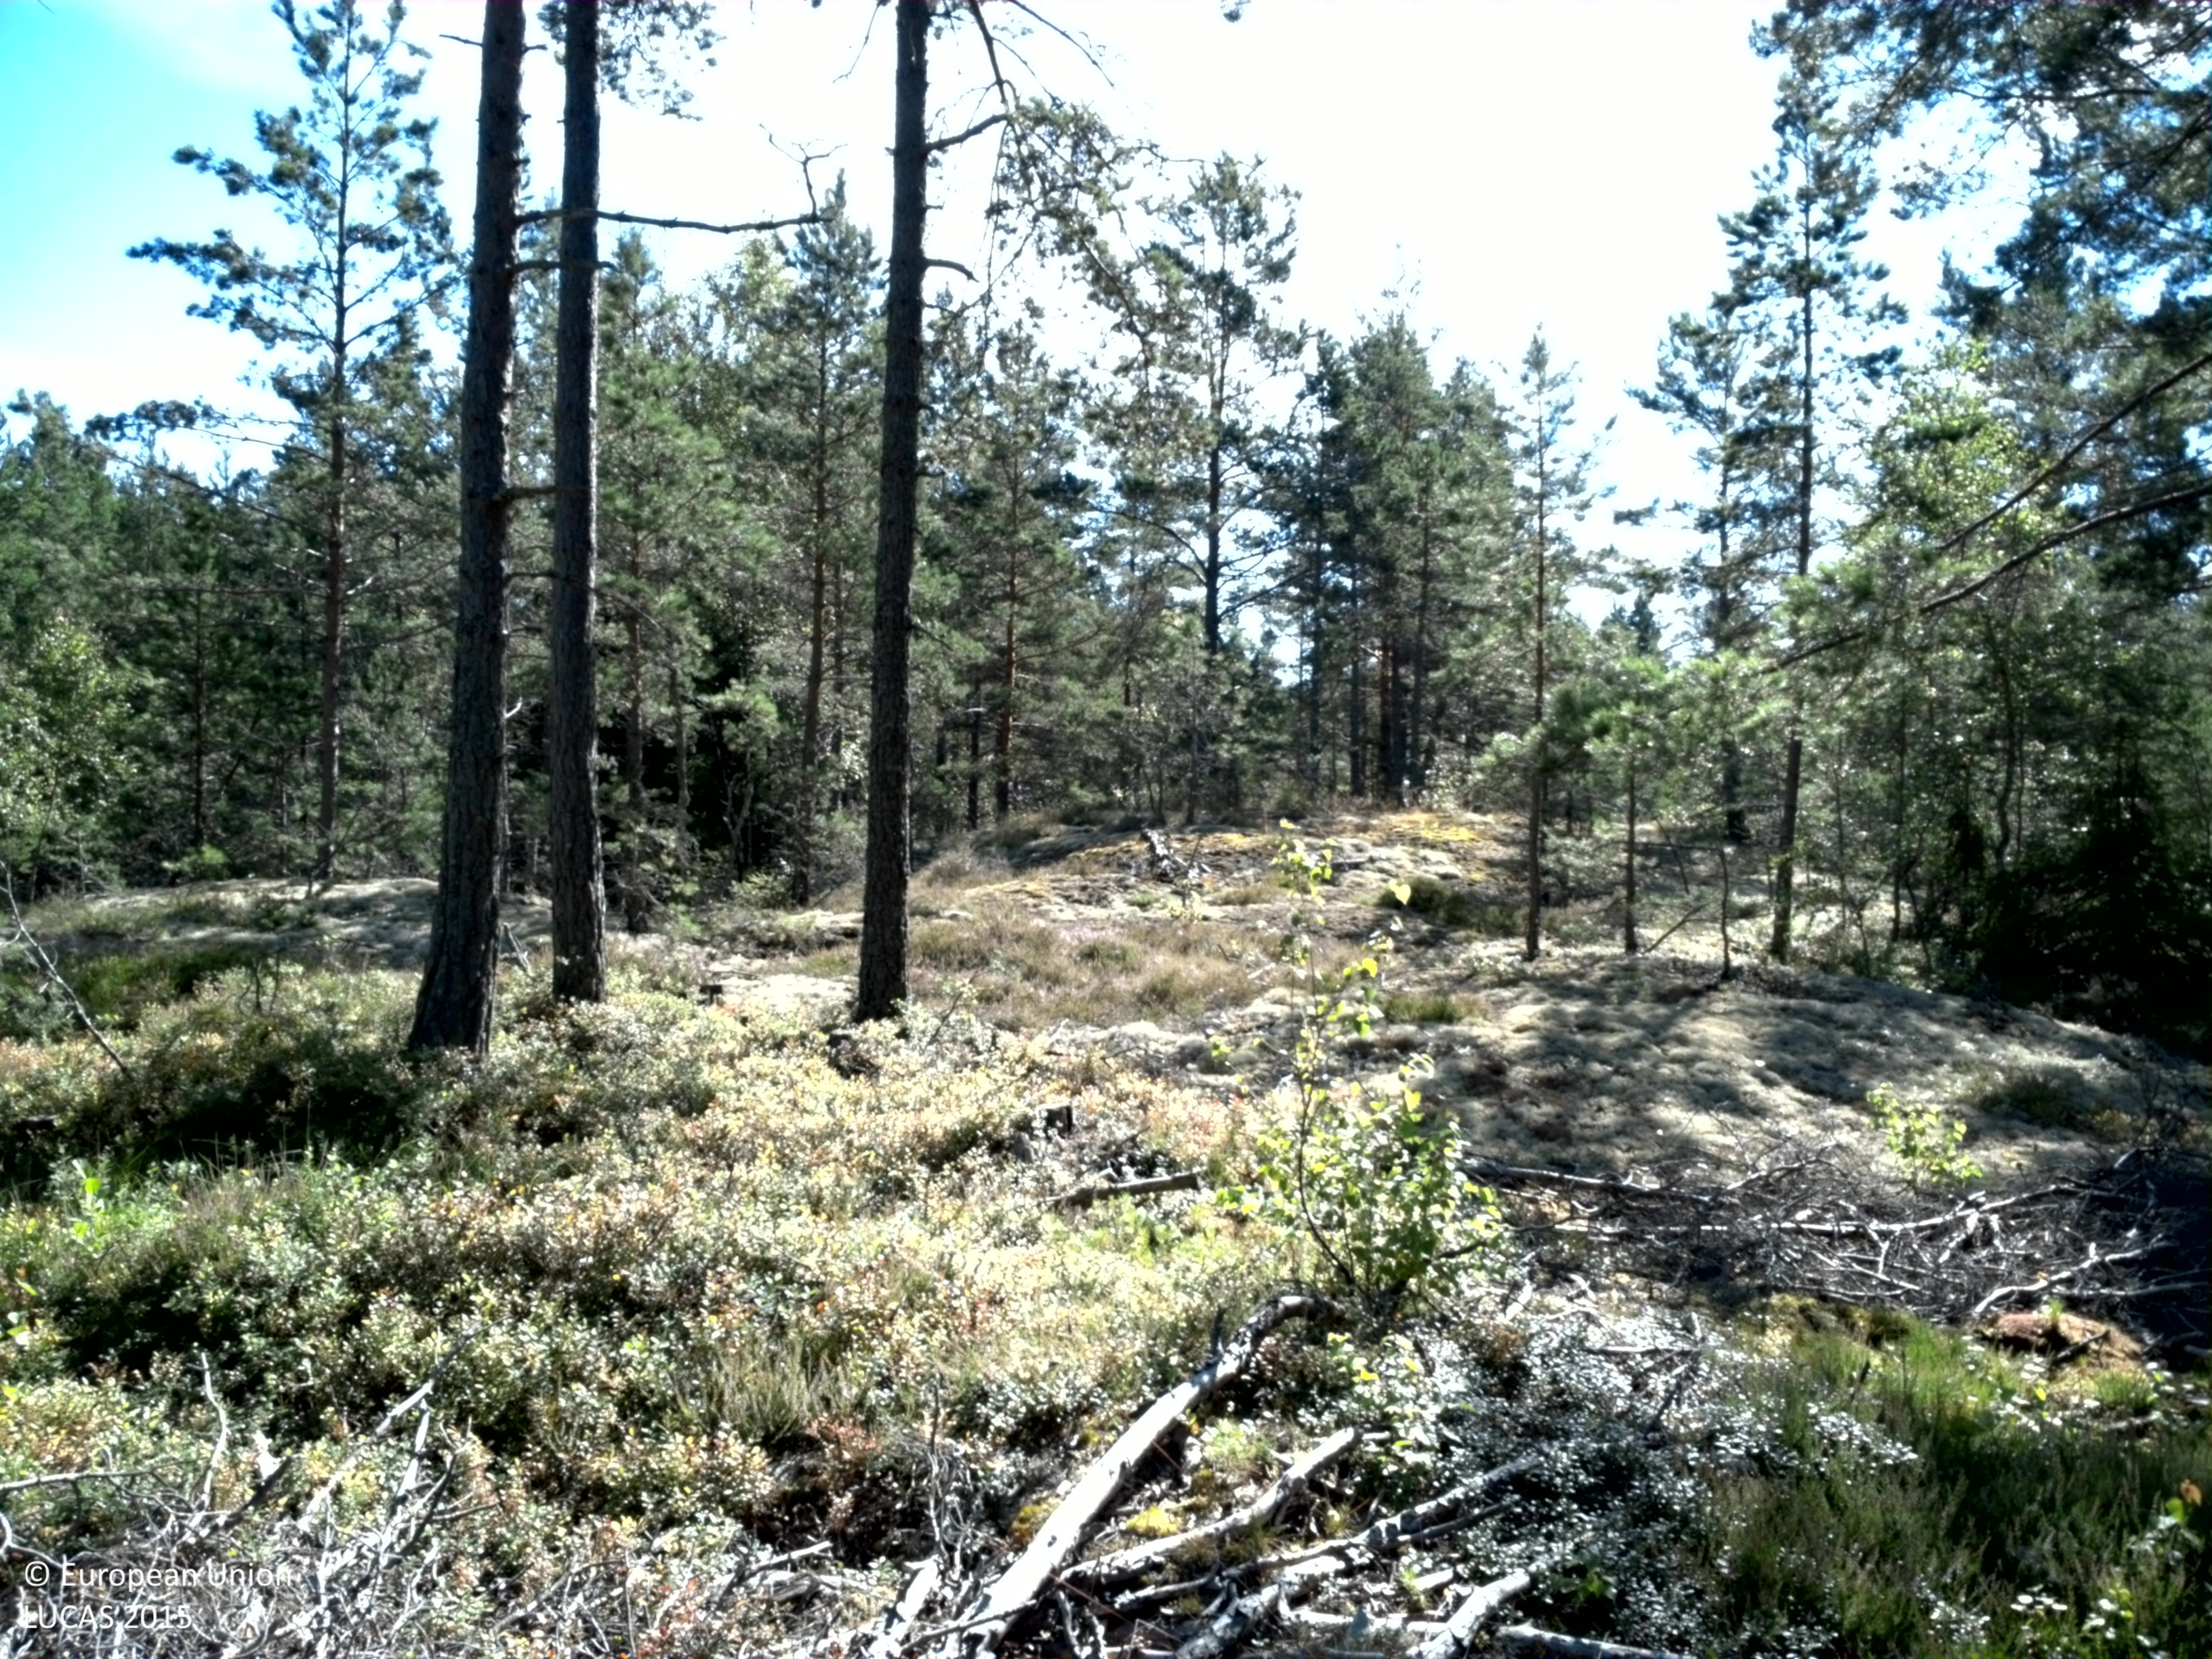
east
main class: Woodland
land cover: Pine dominated coniferous woodland
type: boreal forest
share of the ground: 25 - 50 %
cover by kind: lichens and mosses 45 %, coniferous forest trees 40 %, broadleaved forest trees 5 %, shrubs 5 %, consolidated bare surface 5 %
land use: Forestry
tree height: > 5 m
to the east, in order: Pine dominated coniferous woodland; Spruce dominated coniferous woodland; Pine dominated coniferous woodland
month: August
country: SE
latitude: 59.5587
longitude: 18.5468
